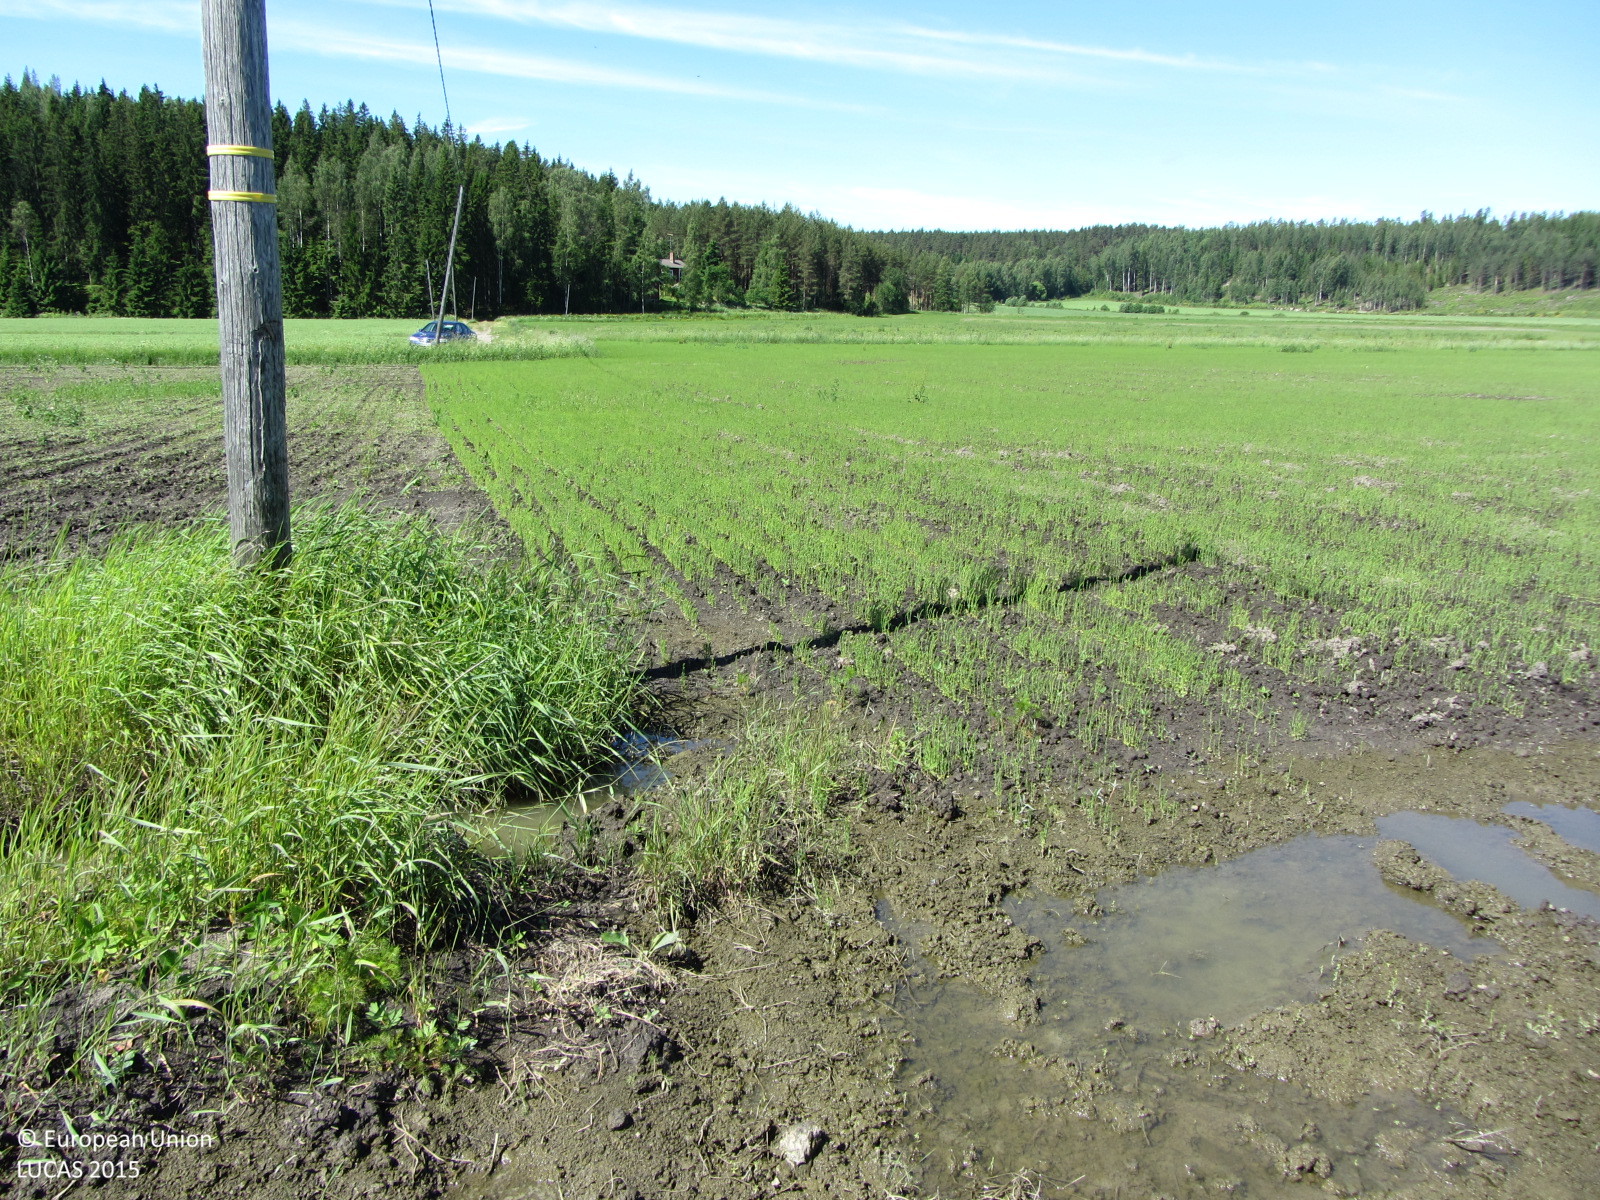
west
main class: Cropland
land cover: Other non-permanent industrial crops
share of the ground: 25 - 50 %
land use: Agriculture (excluding fallow land and kitchen gardens)
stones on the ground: < 10 %
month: June
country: FI
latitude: 60.3383
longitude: 23.2533
